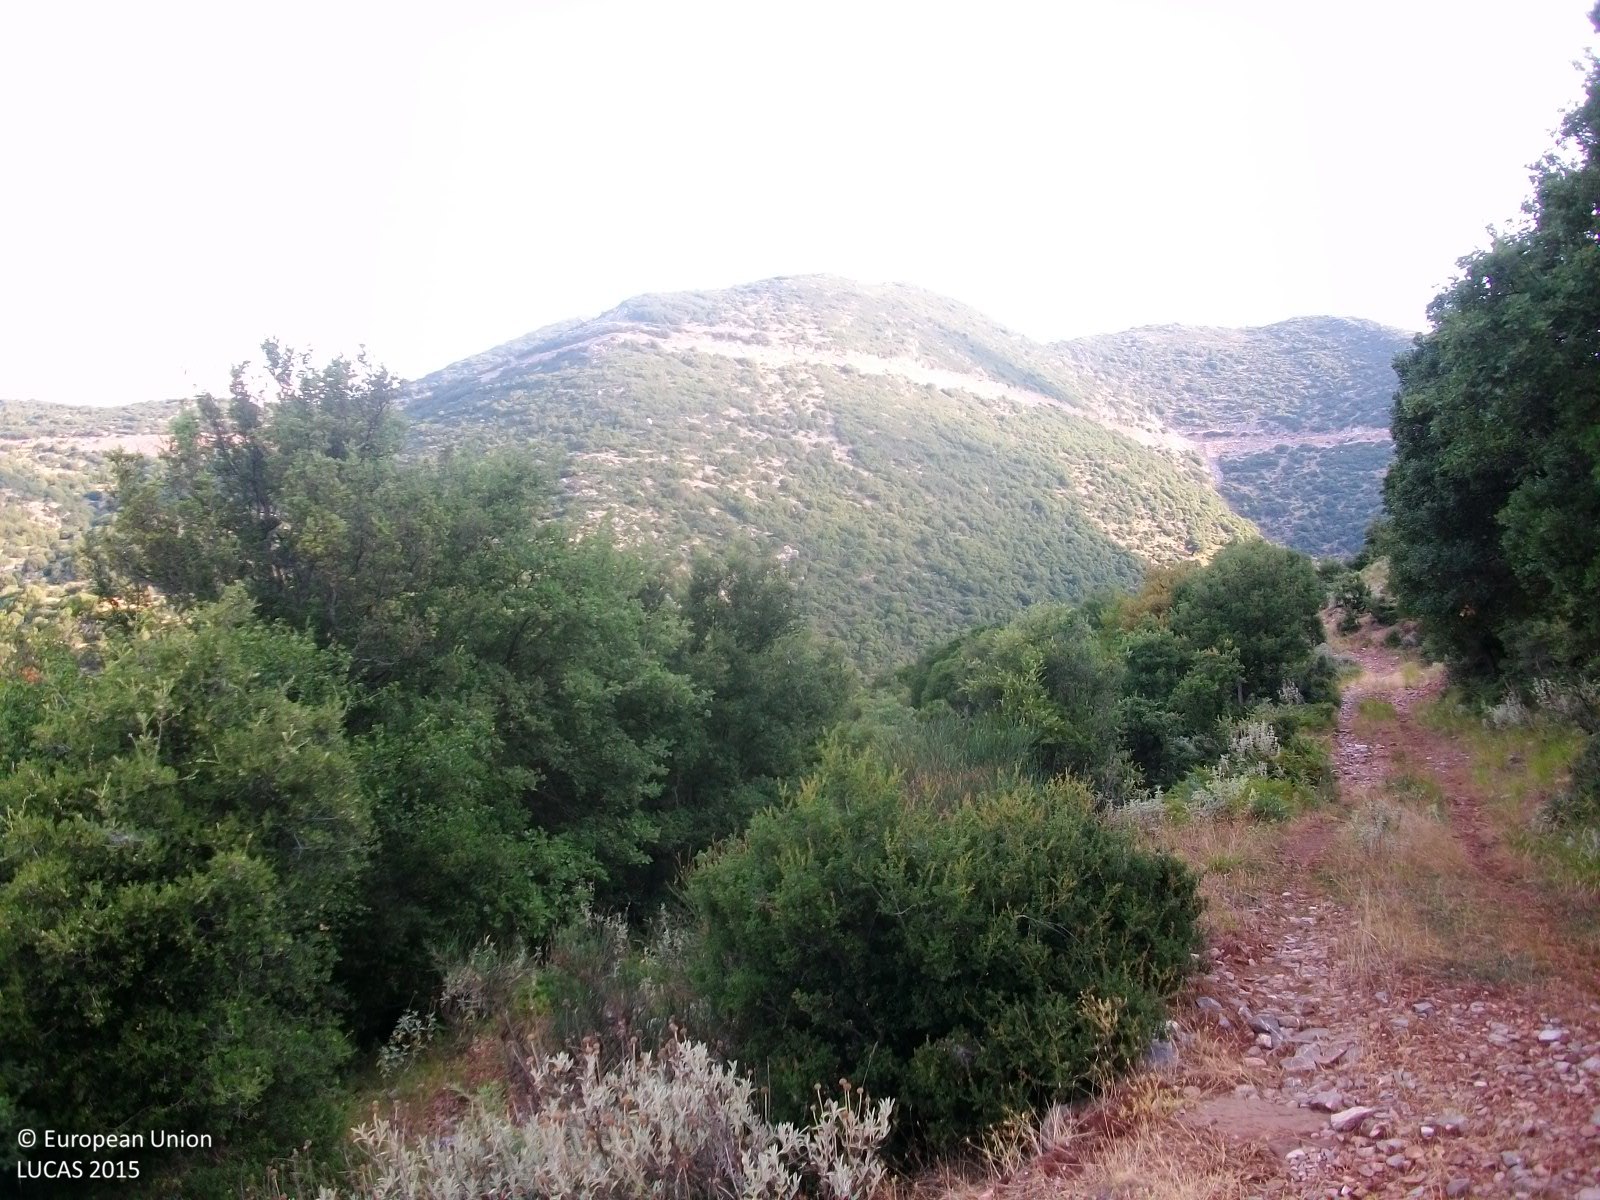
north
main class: Shrubland
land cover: Shrubland with sparse tree cover
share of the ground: > 75 %
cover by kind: shrubs 95 %, broadleaved forest trees 5 %
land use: Semi-natural and natural areas not in use
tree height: > 5 m
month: August
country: GR
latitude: 37.3591
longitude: 21.9361
